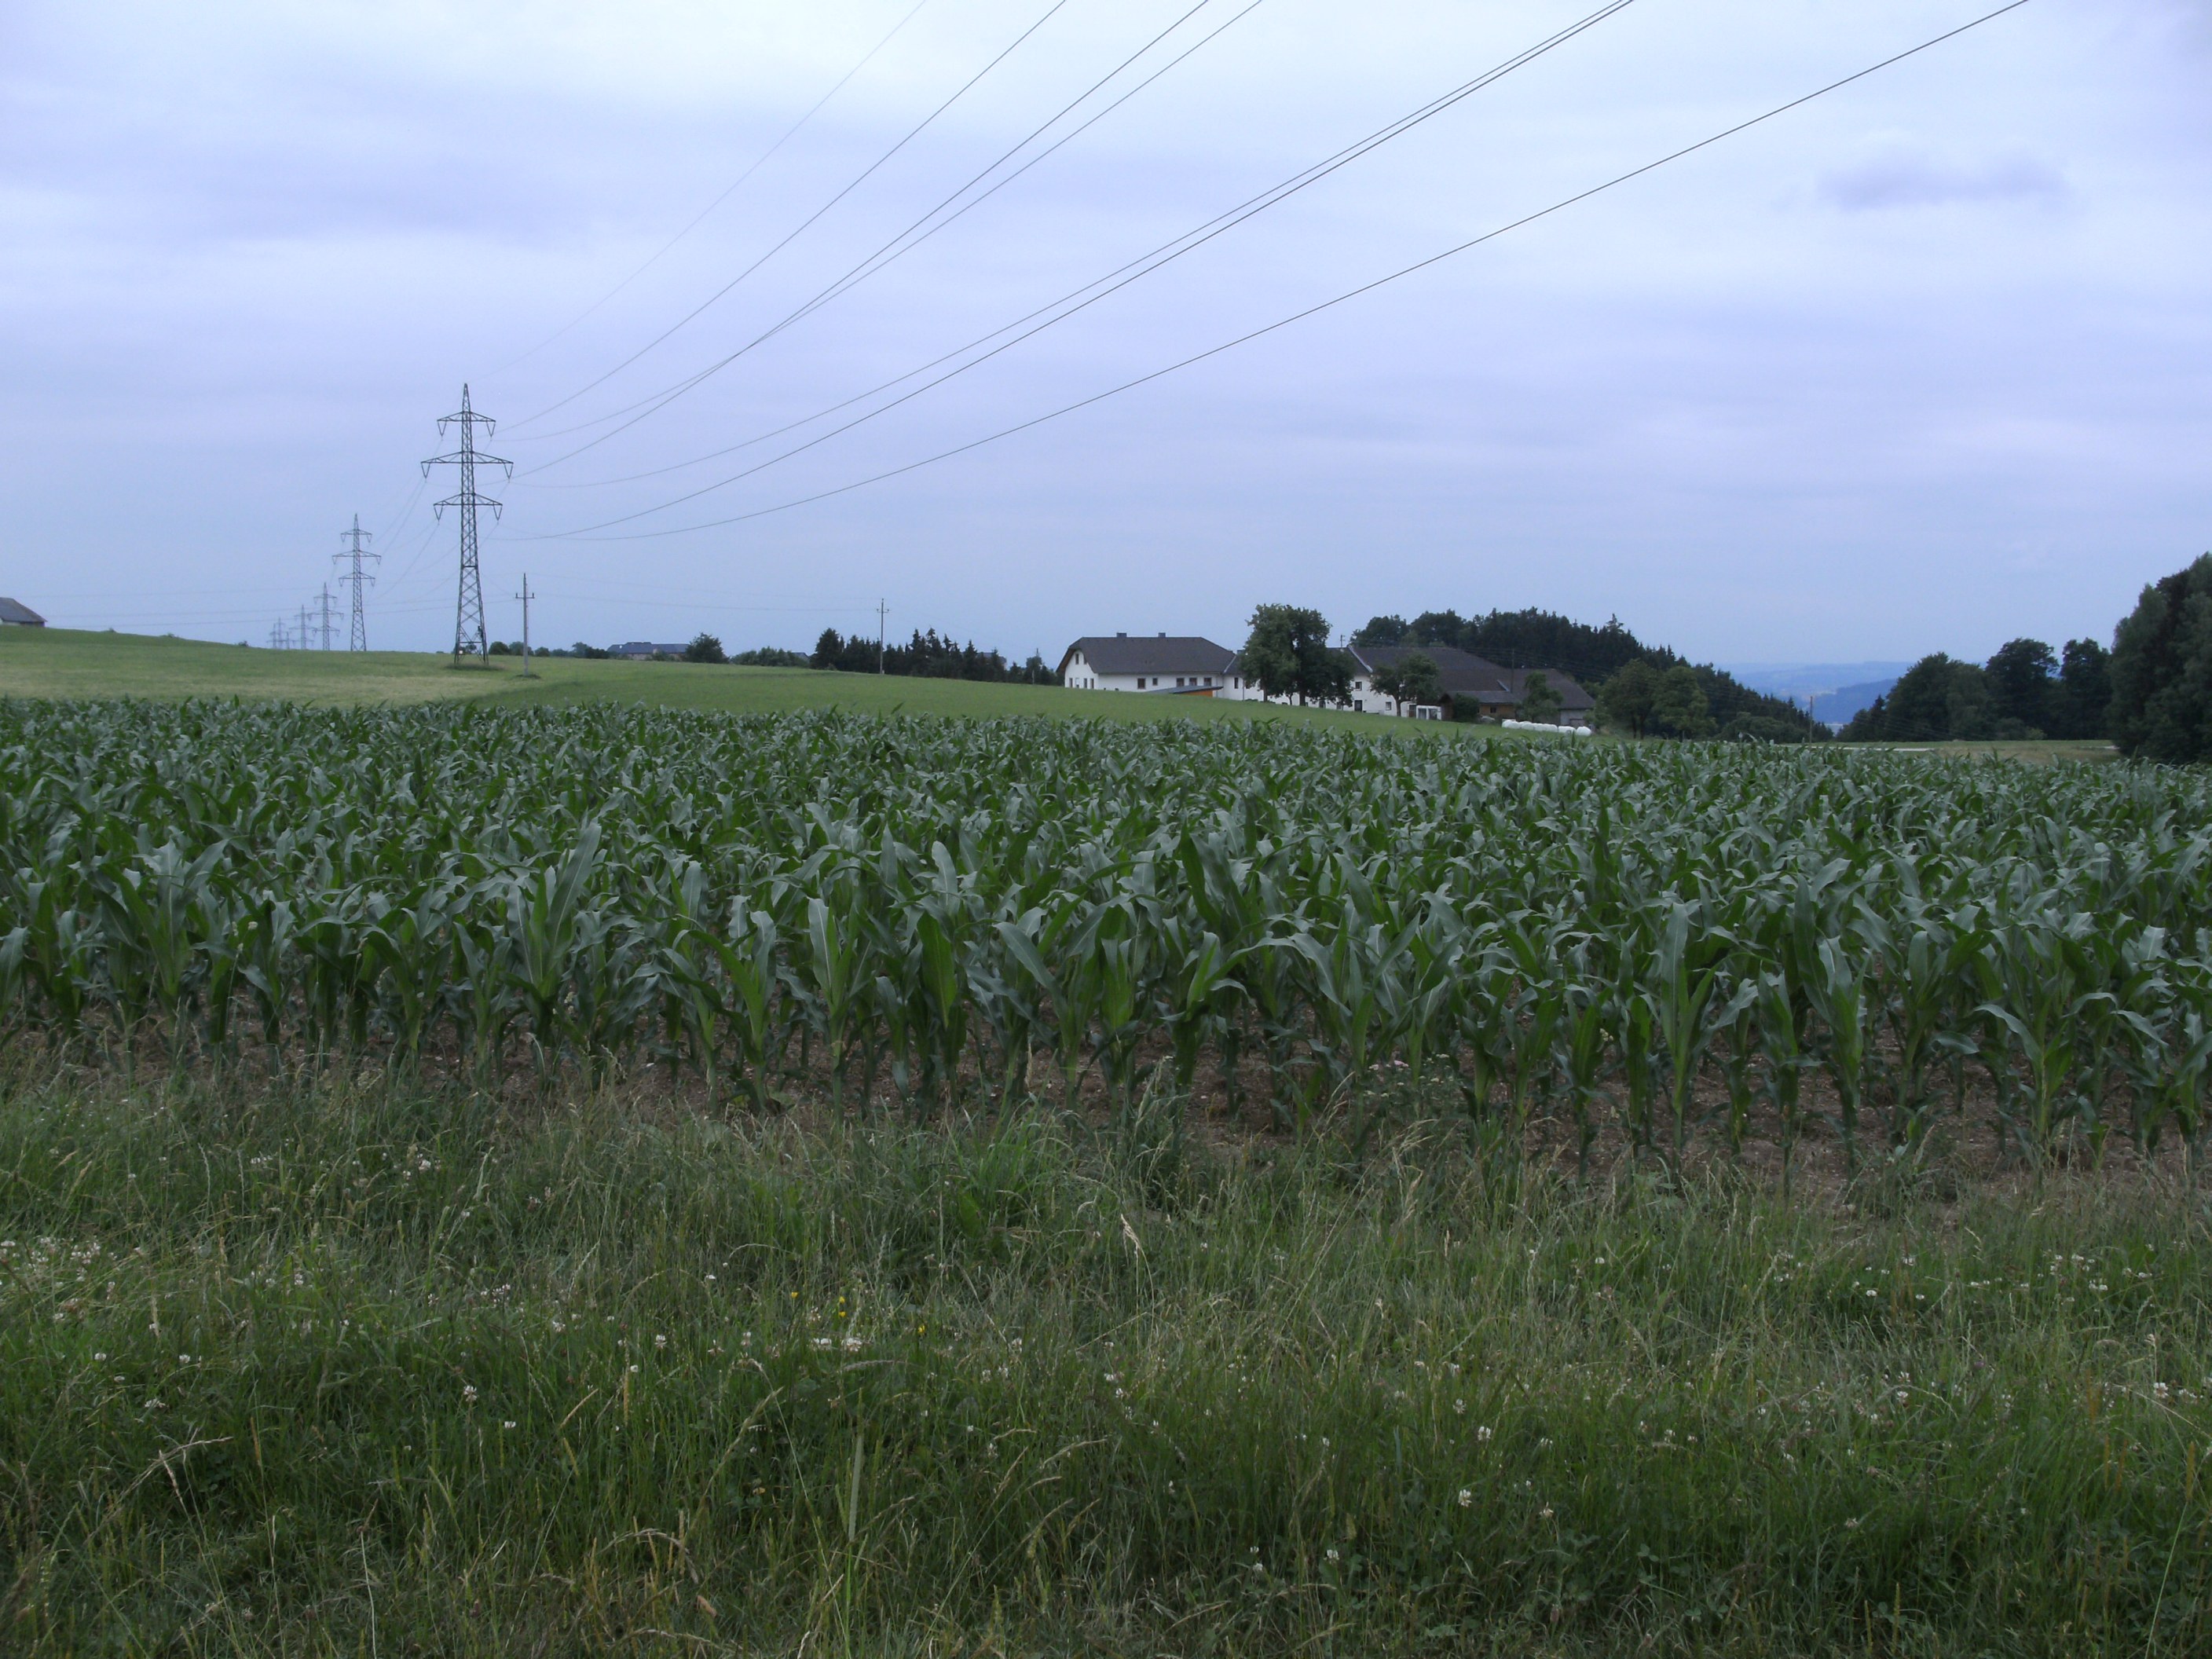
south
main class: Cropland
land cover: Other fibre and oleaginous crops
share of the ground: 25 - 50 %
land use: Agriculture (excluding fallow land and kitchen gardens)
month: June
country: AT
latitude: 48.4018
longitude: 14.0387
